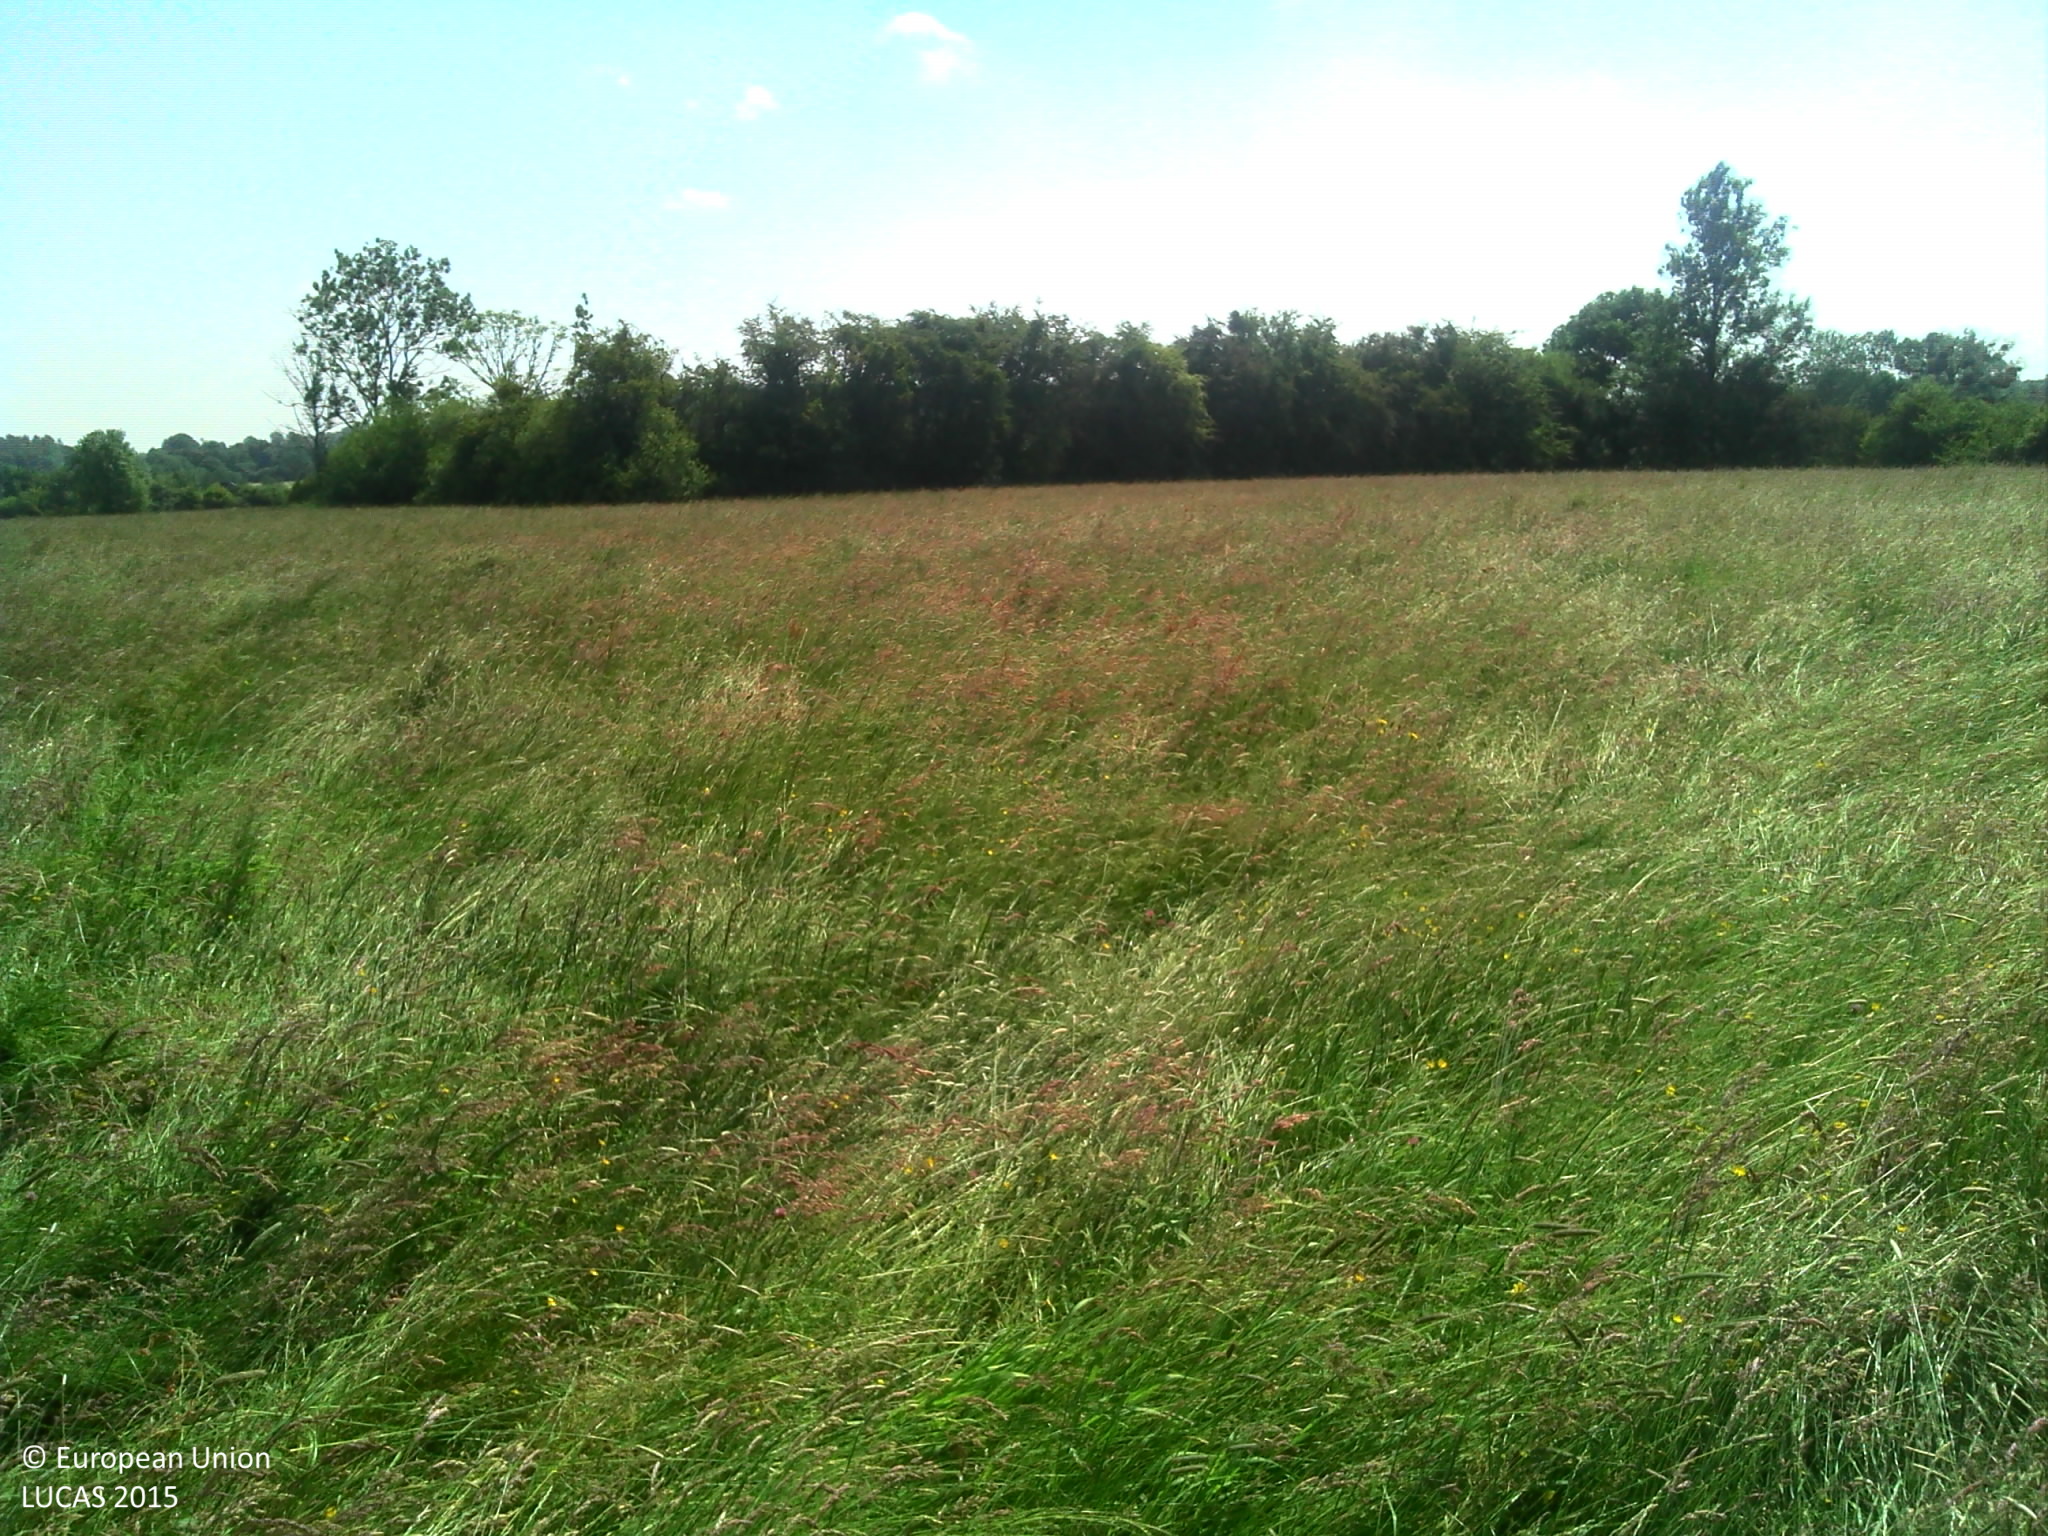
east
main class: Grassland
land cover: Grassland without tree/shrub cover
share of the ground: > 75 %
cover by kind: herbaceous plants 100 %
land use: Agriculture (excluding fallow land and kitchen gardens)
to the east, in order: Managed hedges; Fences; Grassland without tree/shrub cover; Fences; Abandoned hedges; Grassland without tree/shrub cover; Abandoned hedges; Fences; Grassland without tree/shrub cover; Managed hedges; Abandoned hedges; Grassland without tree/shrub cover
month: June
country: FR
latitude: 49.8159
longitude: 4.1161
